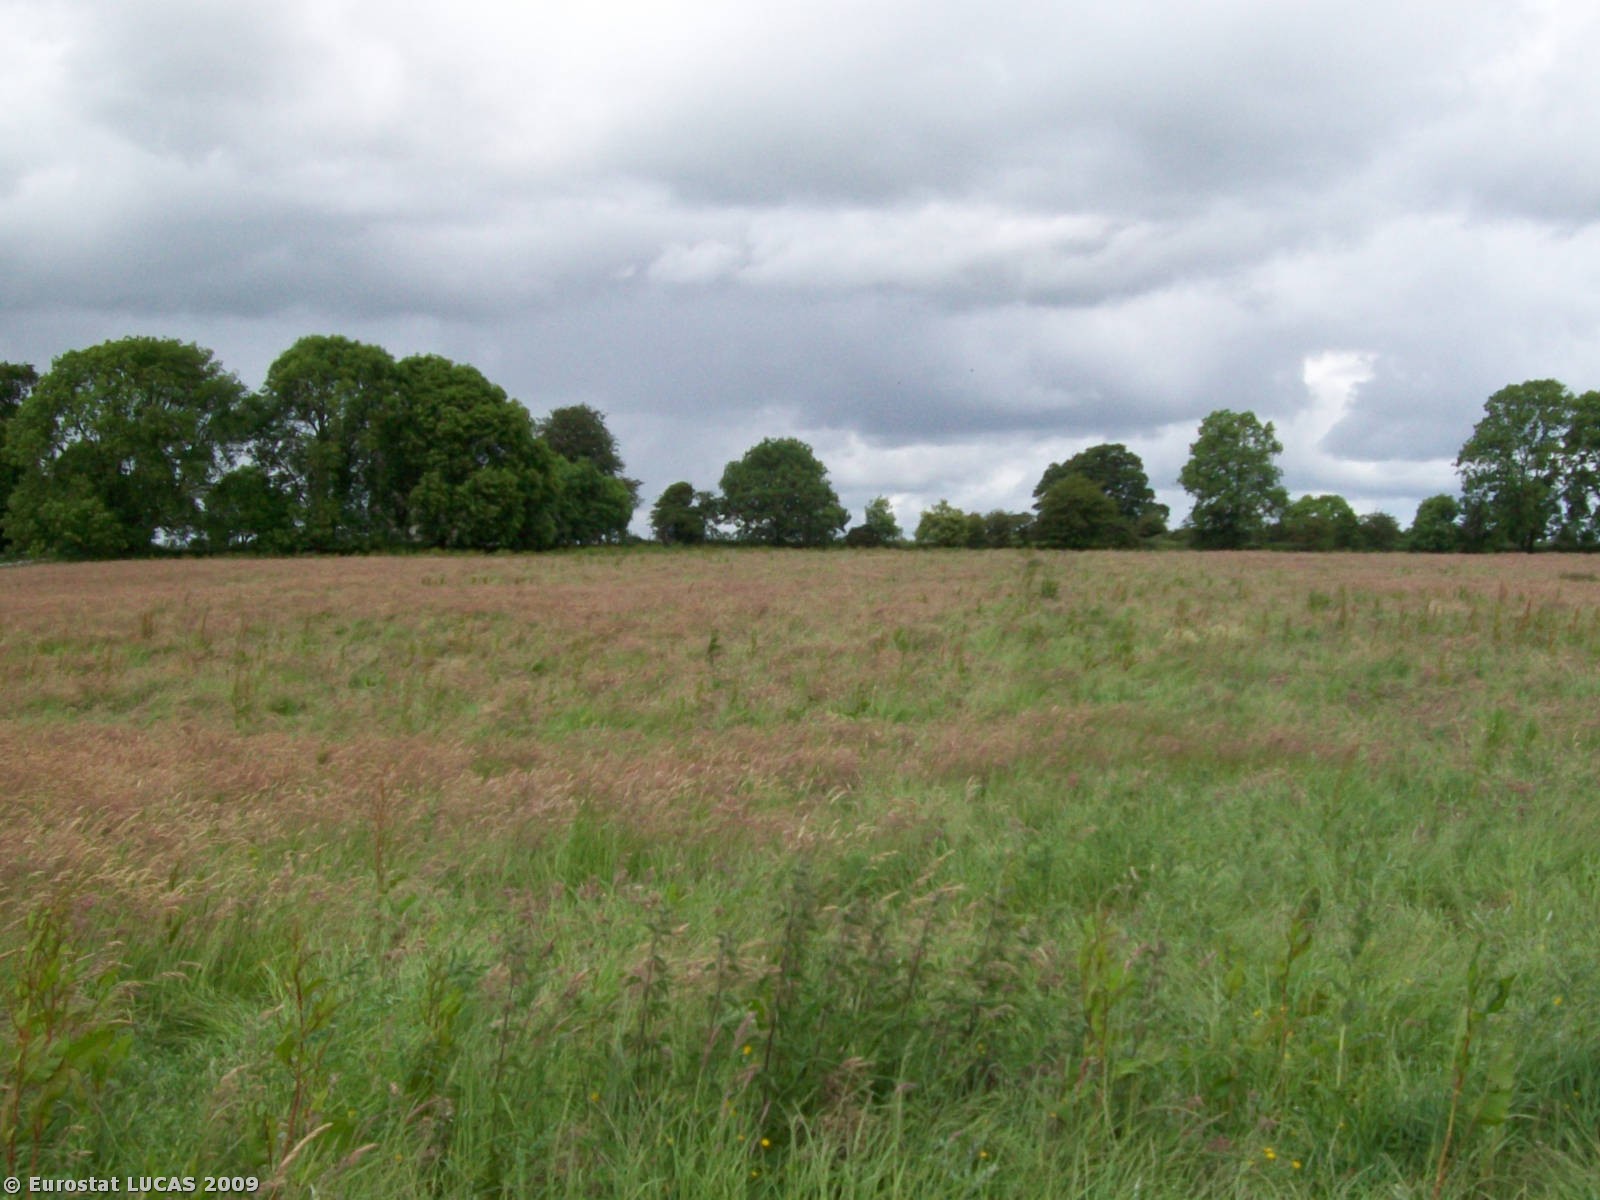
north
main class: Grassland
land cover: Grassland without tree/shrub cover
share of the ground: > 75 %
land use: Agriculture (excluding fallow land and kitchen gardens)
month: June
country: IE
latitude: 53.3838
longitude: -8.8336
